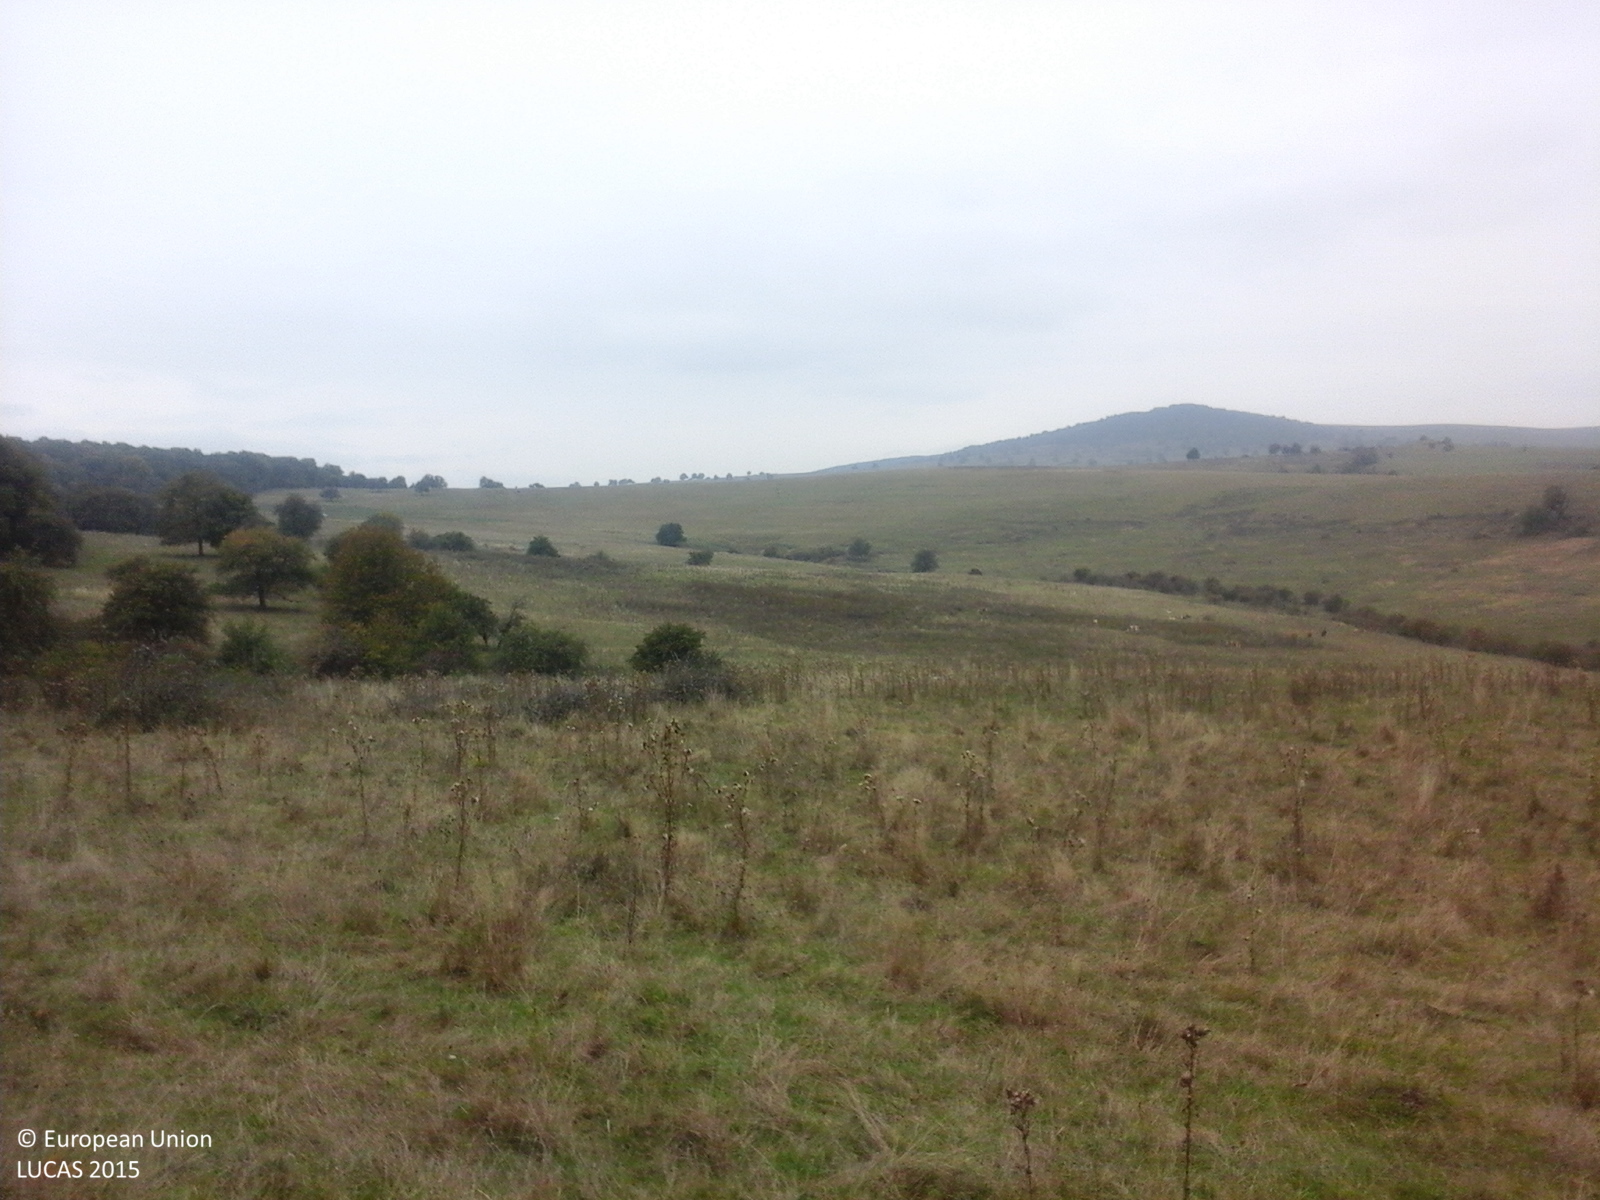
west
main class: Grassland
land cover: Grassland without tree/shrub cover
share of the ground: > 75 %
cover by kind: herbaceous plants 100 %
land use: Agriculture (excluding fallow land and kitchen gardens)
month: October
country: RO
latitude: 46.0965
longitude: 25.2203
